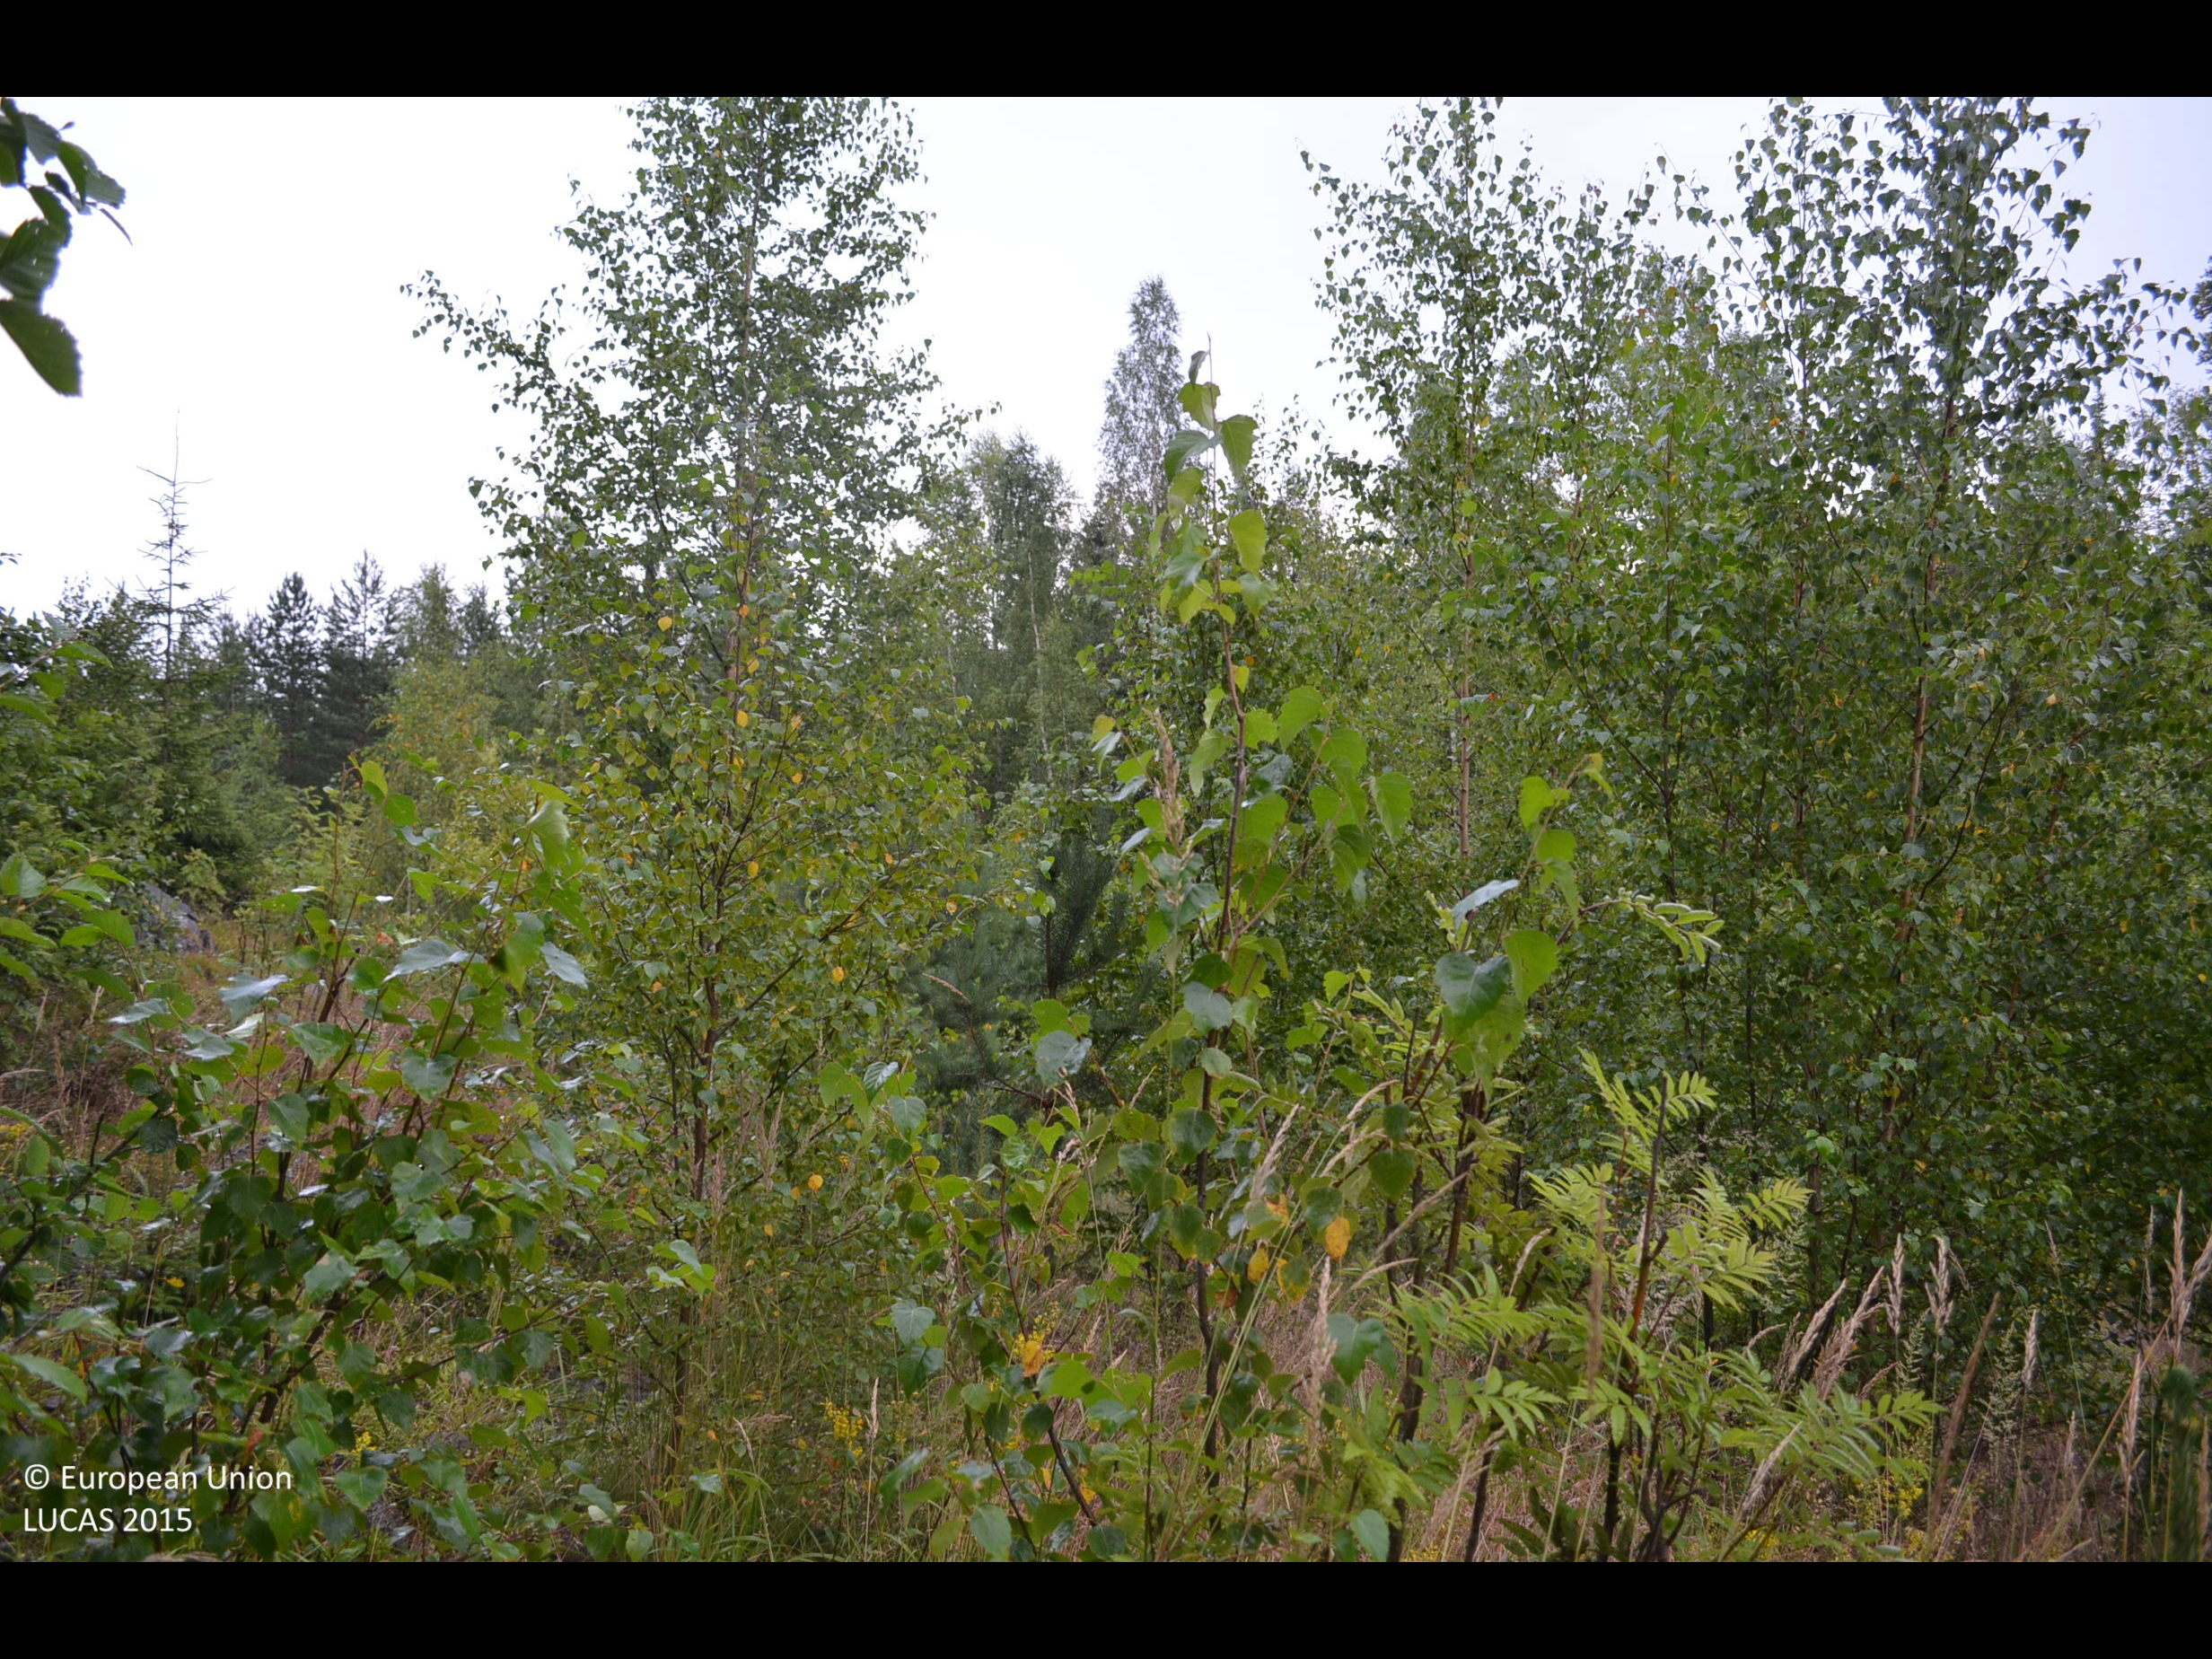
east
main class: Woodland
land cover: Broadleaved woodland
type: boreal forest
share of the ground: 50 - 75 %
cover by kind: broadleaved forest trees 45 %, herbaceous plants 20 %, consolidated bare surface 15 %, coniferous forest trees 10 %, shrubs 10 %
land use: Forestry
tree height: < 5 m
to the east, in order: Broadleaved woodland; Spruce dominated mixed woodland; Other coniferous woodland; Pine dominated mixed woodland; Other coniferous woodland
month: August
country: FI
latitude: 61.5272
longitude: 23.0648
